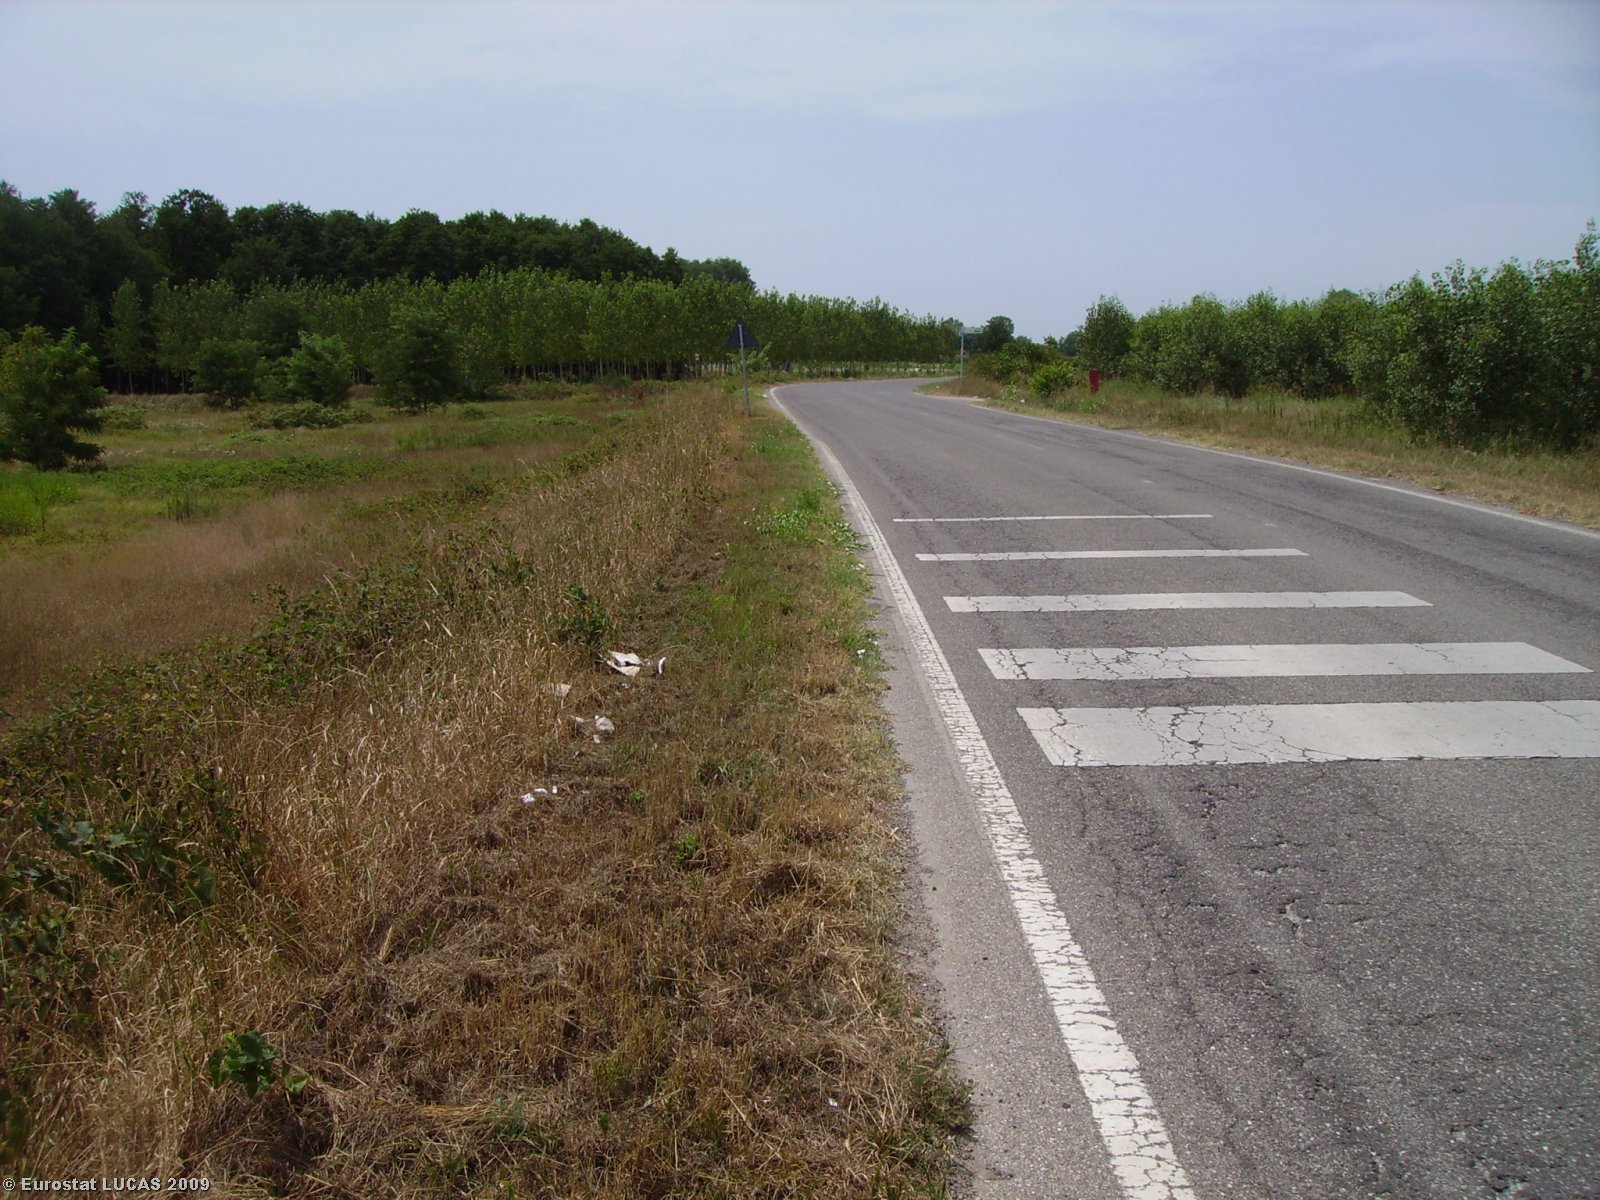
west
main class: Grassland
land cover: Spontaneously vegetated surfaces
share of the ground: > 75 %
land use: Fallow land
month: July
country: IT
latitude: 45.2135
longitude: 9.2755
